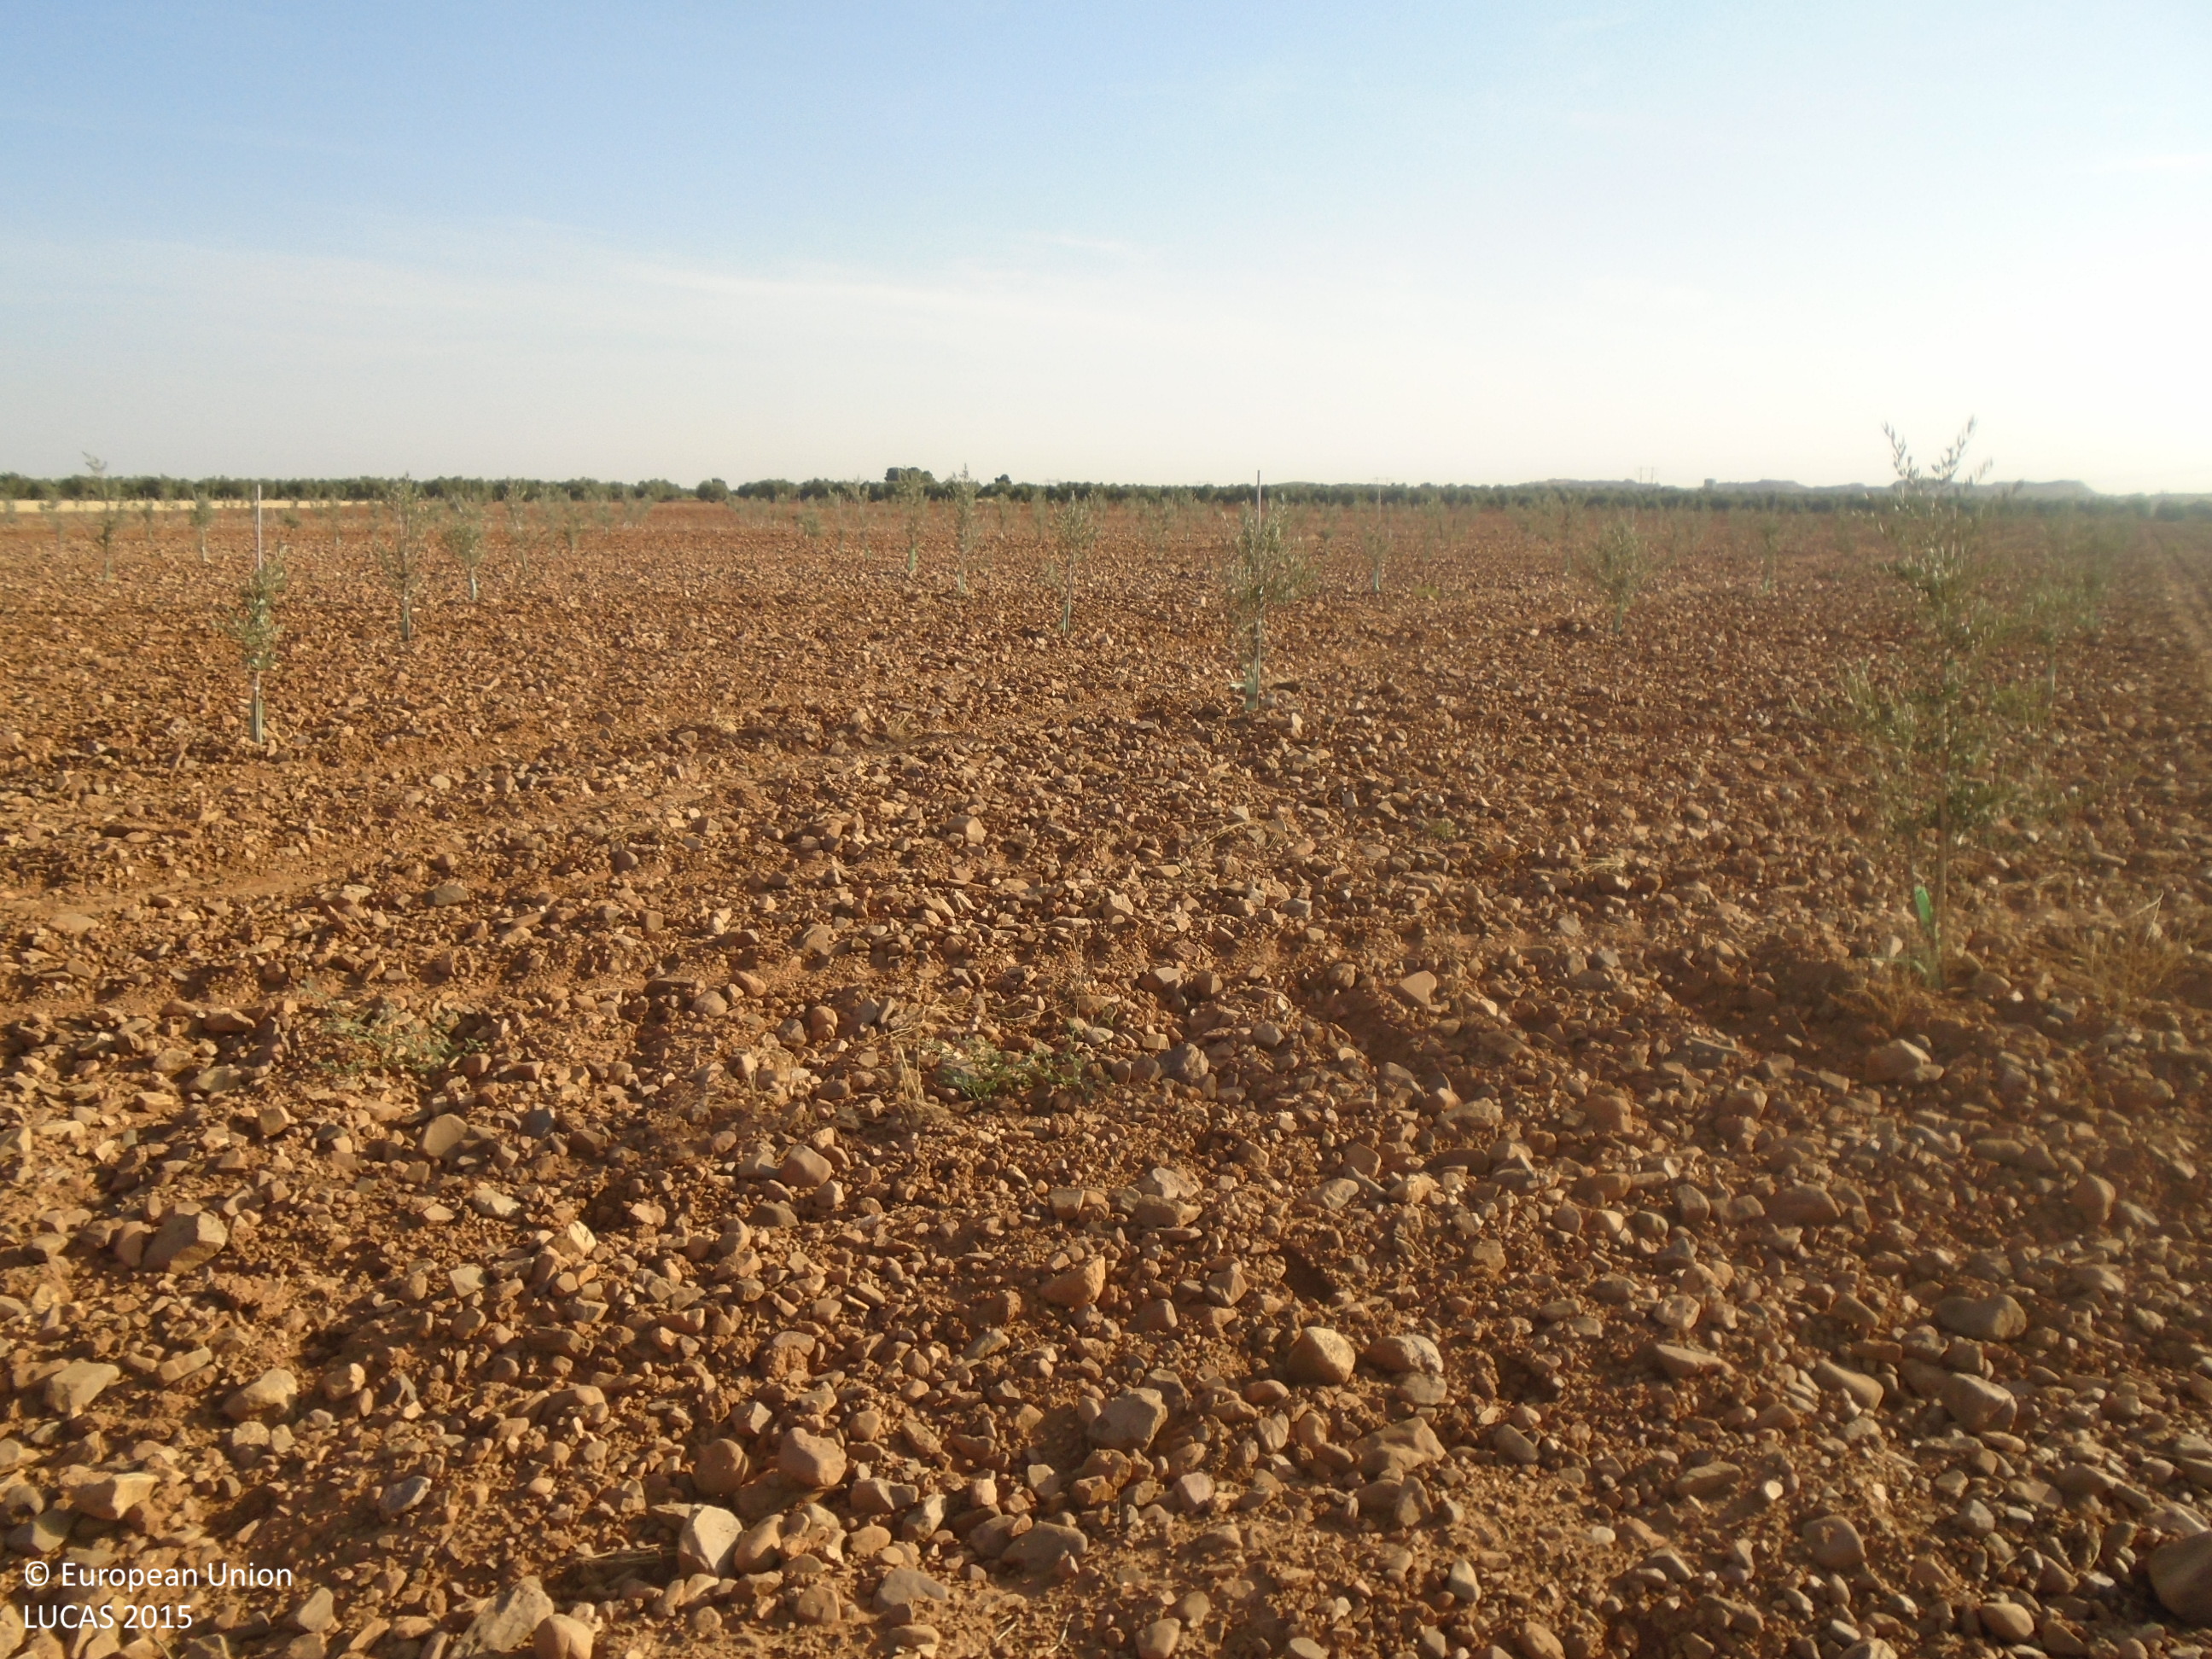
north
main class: Cropland
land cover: Olive groves
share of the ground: < 10 %
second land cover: Other bare soil
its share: > 75 %
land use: Agriculture (excluding fallow land and kitchen gardens)
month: July
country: ES
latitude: 39.3457
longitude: -3.5154
